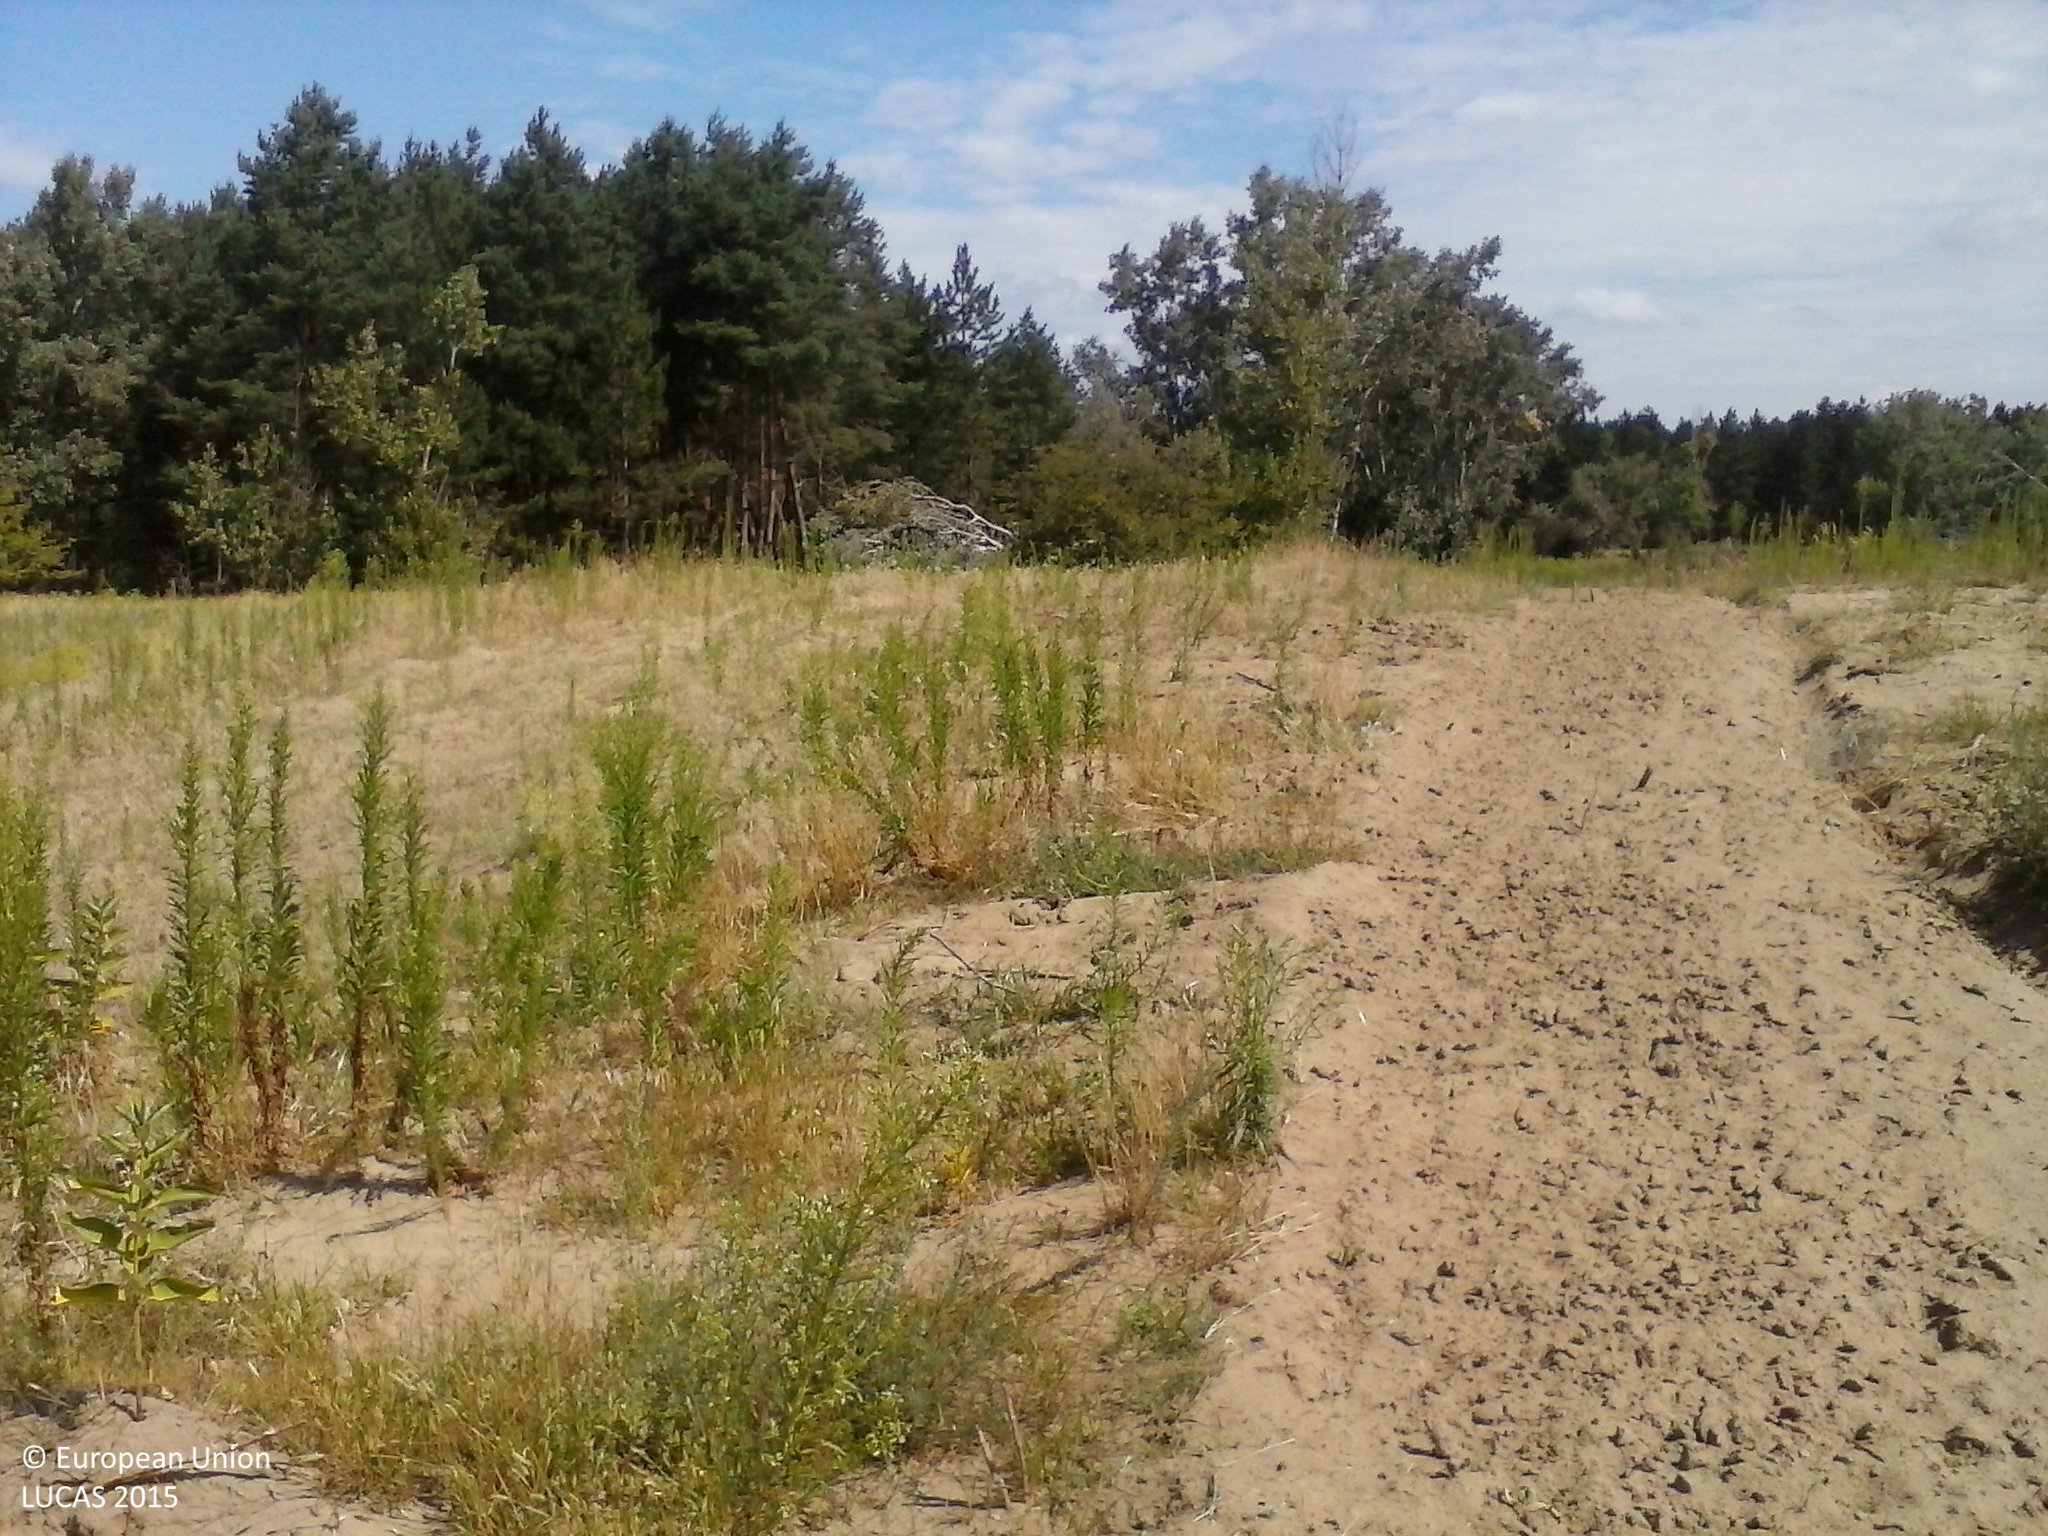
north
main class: Grassland
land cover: Spontaneously vegetated surfaces
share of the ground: 50 - 75 %
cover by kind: herbaceous plants 70 %, unconsolidated bare surface 25 %
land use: Forestry
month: July
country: HU
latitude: 46.5930
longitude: 19.5597
